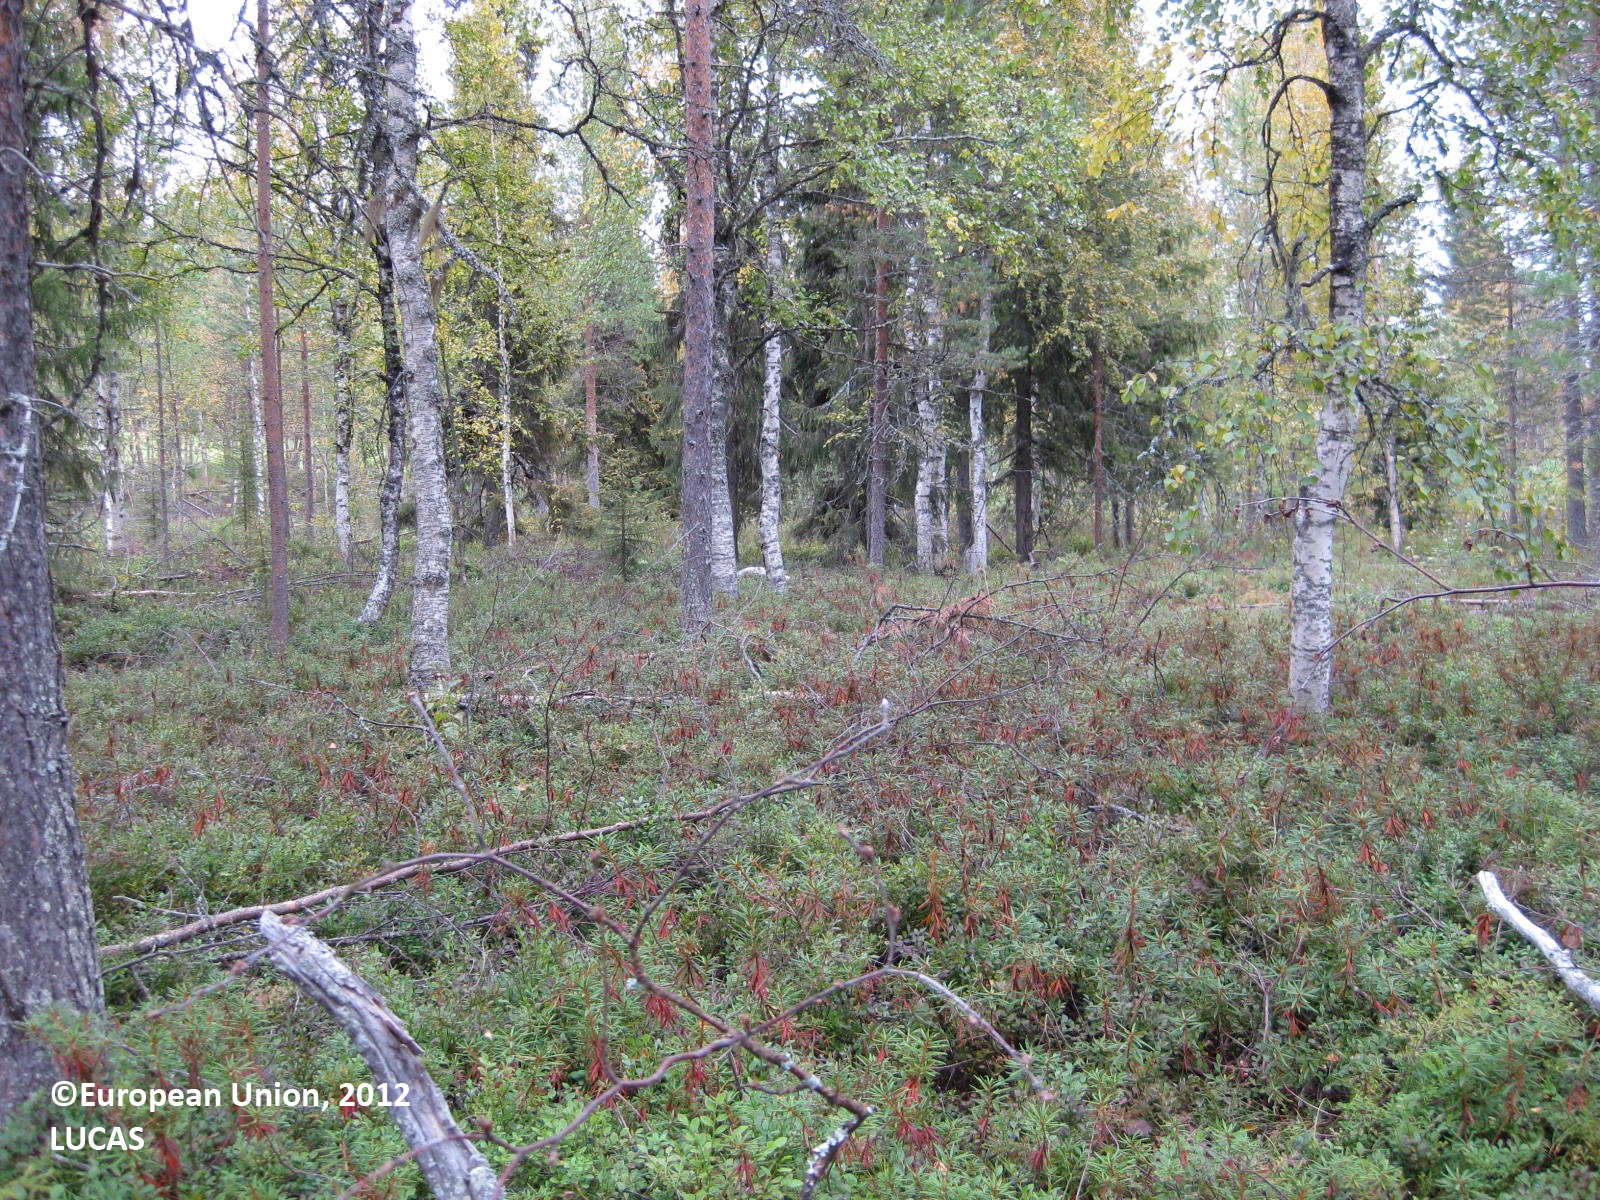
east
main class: Woodland
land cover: Pine dominated mixed woodland
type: boreal forest
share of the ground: 25 - 50 %
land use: Forestry
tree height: > 5 m
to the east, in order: Pine dominated mixed woodland; Ditches and canals; Pine dominated mixed woodland; Fences; Broadleaved woodland; Grass margins; Tracks; Broadleaved woodland; Temporary grasslands; Fences; Other coniferous woodland; Pine dominated mixed woodland
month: August
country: FI
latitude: 65.9680
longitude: 29.6269
